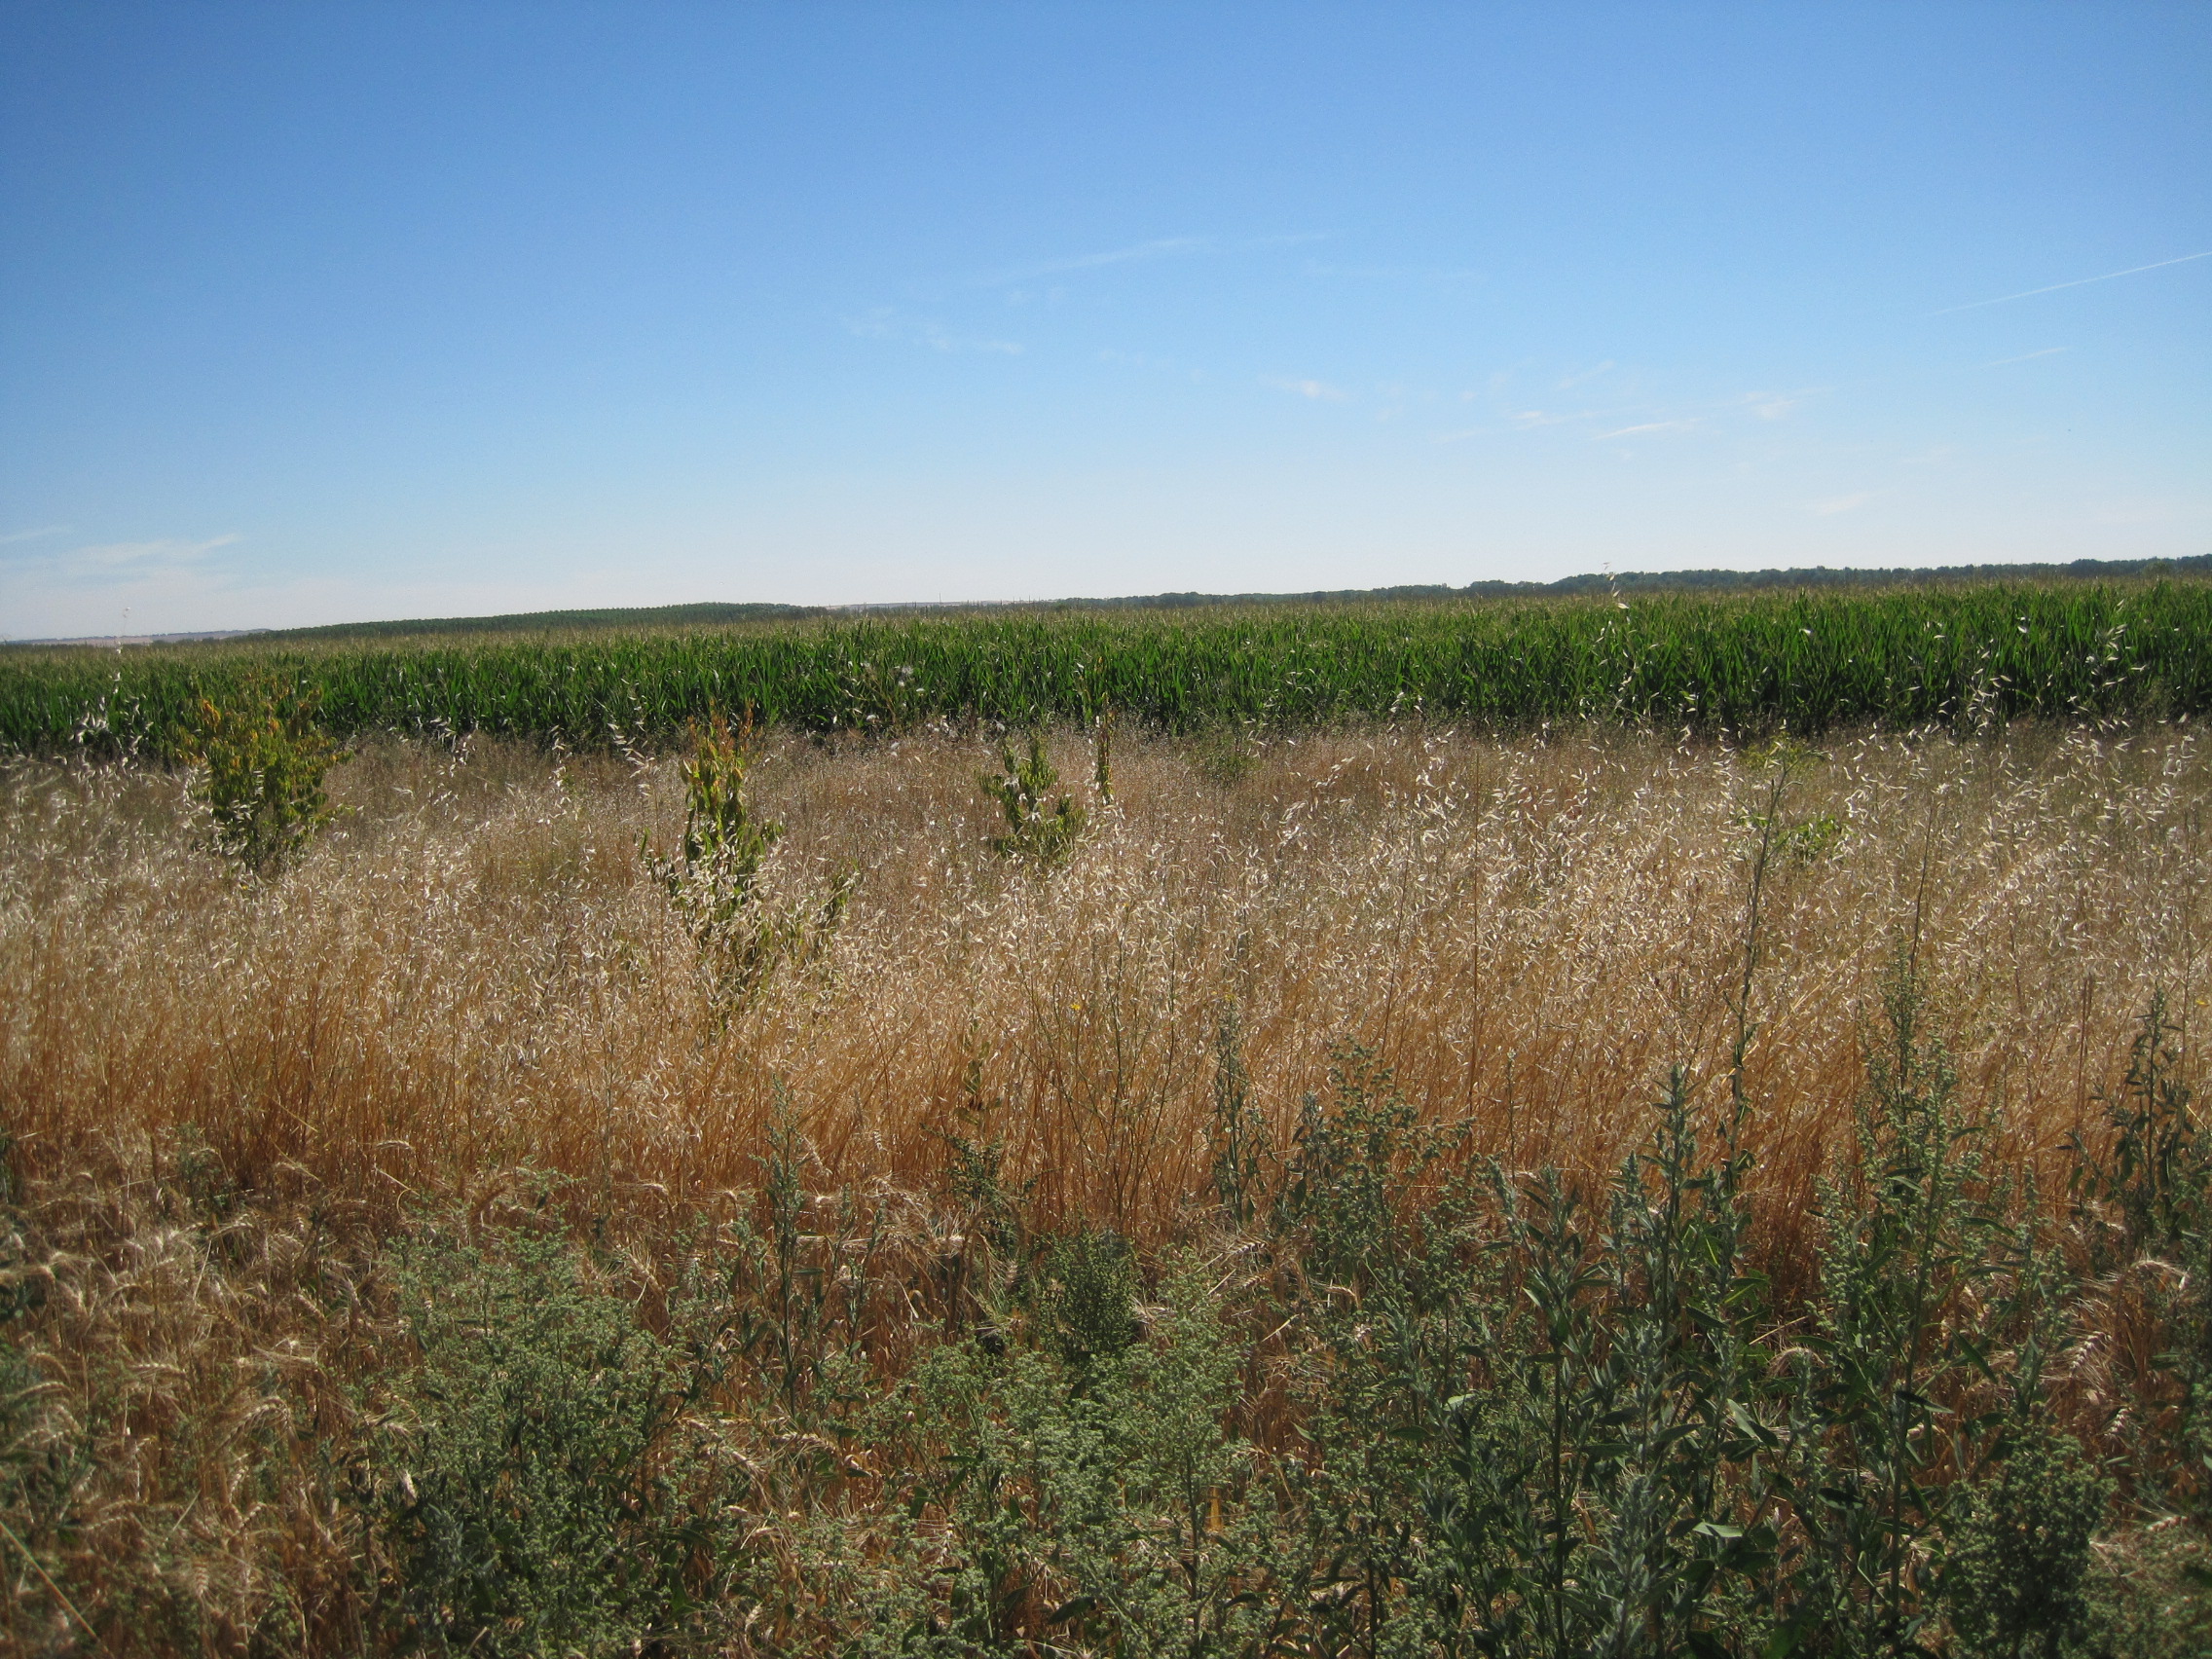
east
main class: Cropland
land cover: Common wheat
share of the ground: > 75 %
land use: Agriculture (excluding fallow land and kitchen gardens)
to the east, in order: Common wheat; Grass margins; Grassland with sparse tree/shrub cover; Maize; Grass margins; Common wheat; Grass margins; Maize; Grass margins; Tracks; Grass margins; Maize; Grass margins; Maize
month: July
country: ES
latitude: 42.1711
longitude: -5.5992
